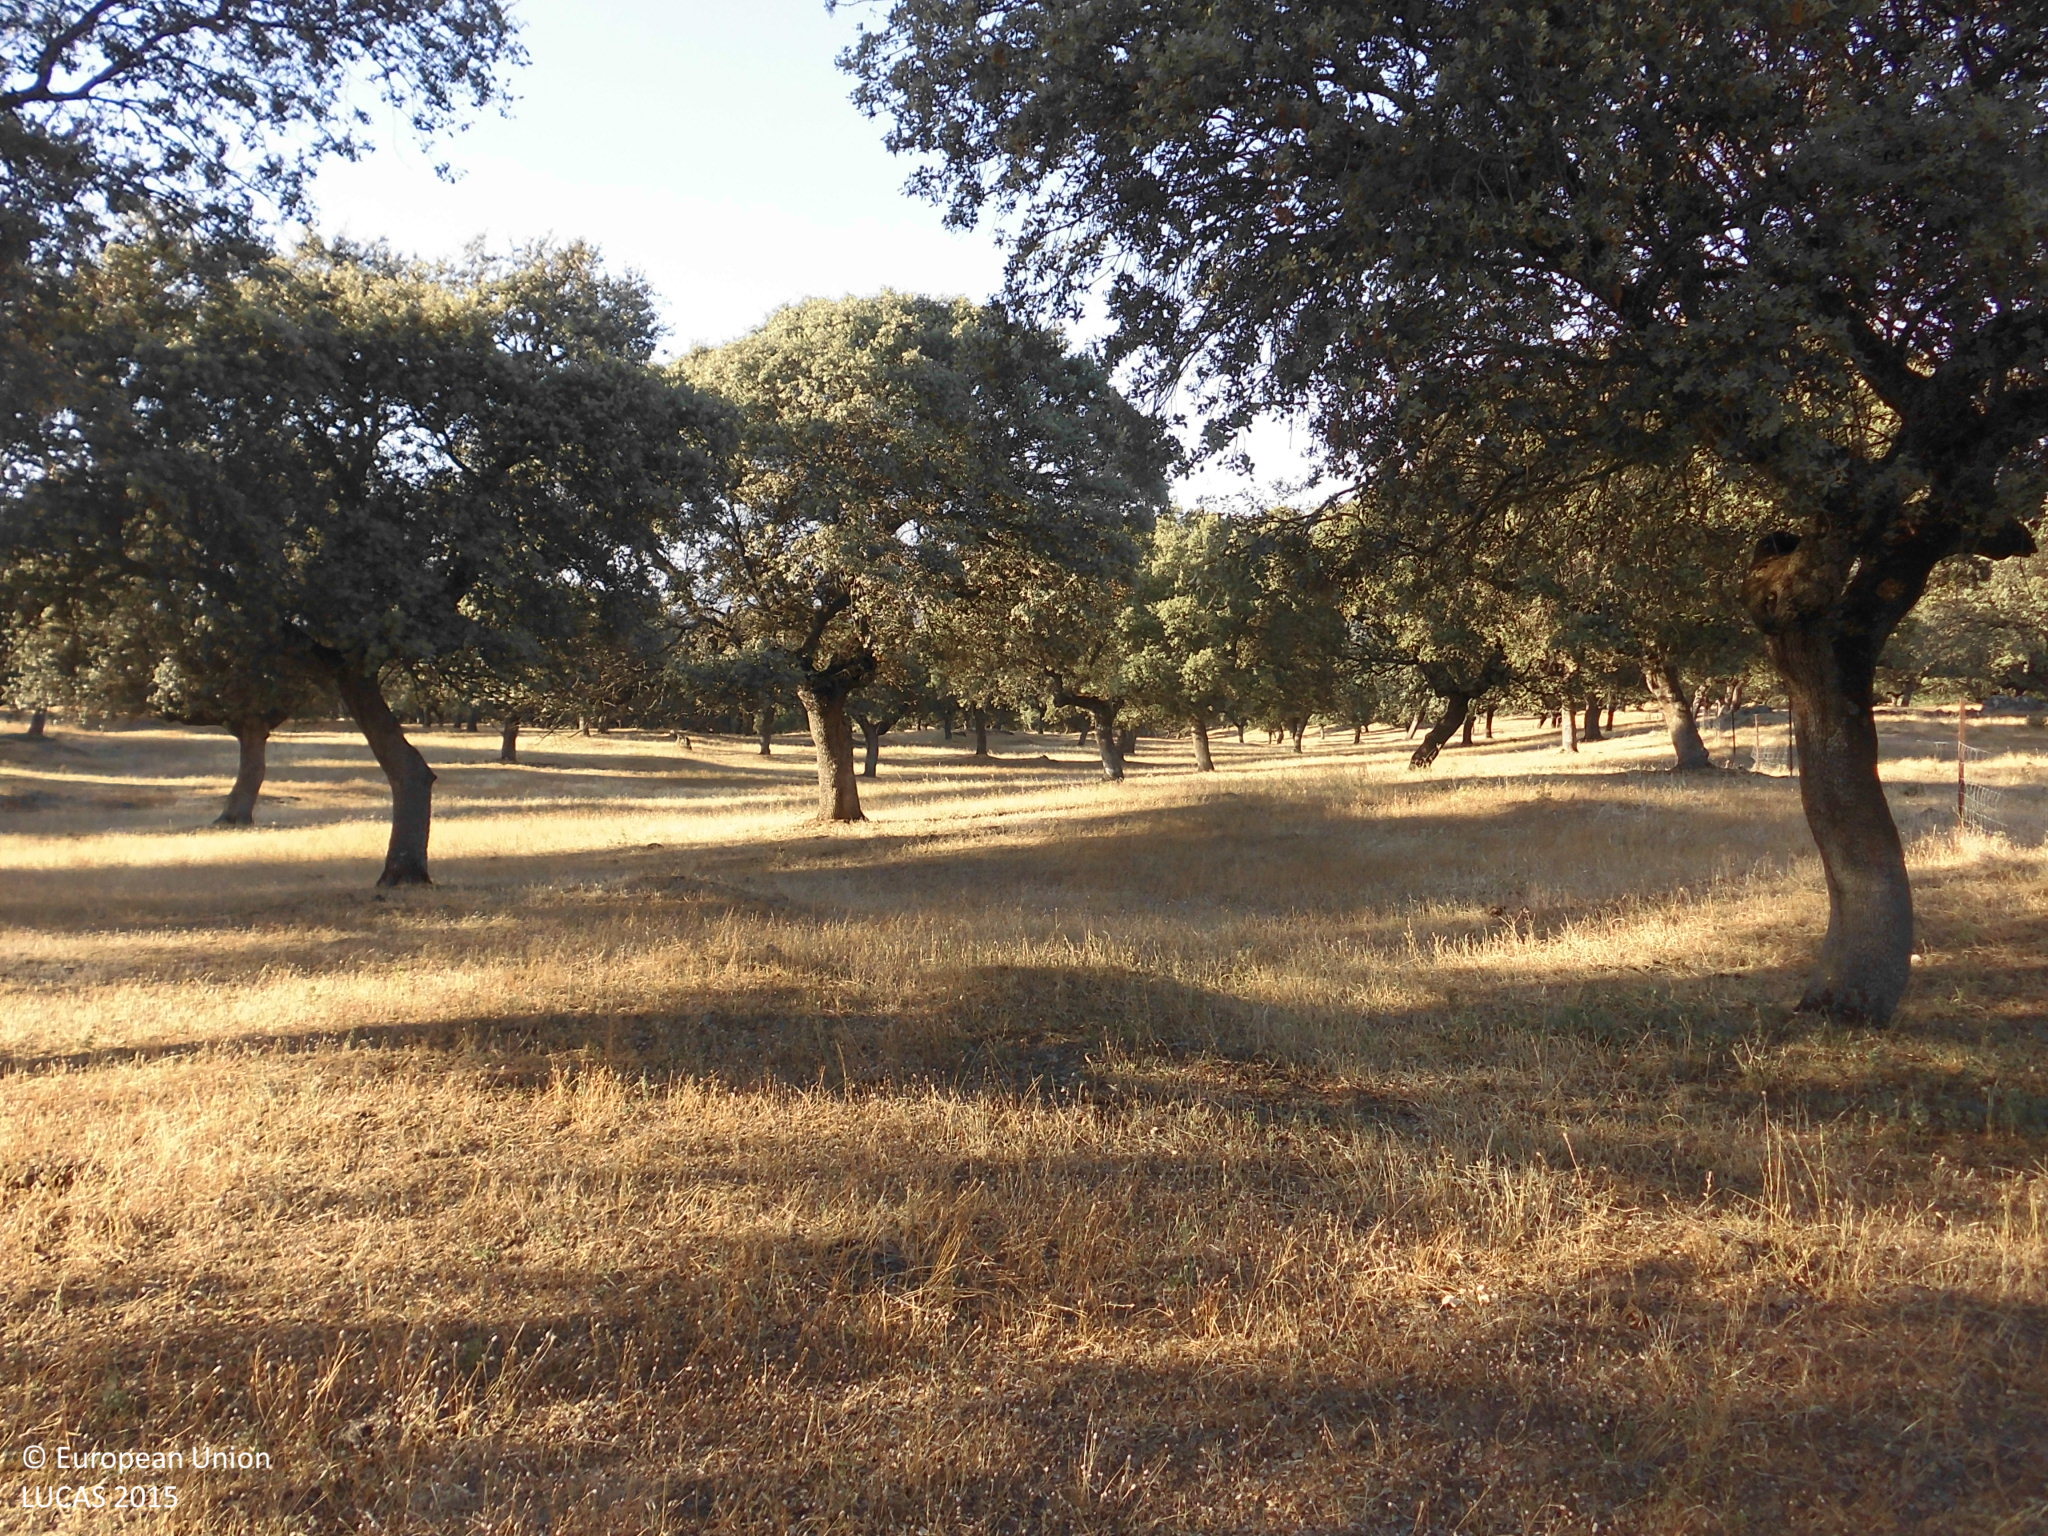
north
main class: Woodland
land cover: Broadleaved woodland
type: broadleaved evergreen forest
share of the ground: 25 - 50 %
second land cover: Grassland without tree/shrub cover
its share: > 75 %
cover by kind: broadleaved forest trees 50 %, herbaceous plants 50 %
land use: Forestry
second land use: Agriculture (excluding fallow land and kitchen gardens)
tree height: > 5 m
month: July
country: ES
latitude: 39.4928
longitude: -5.5762
